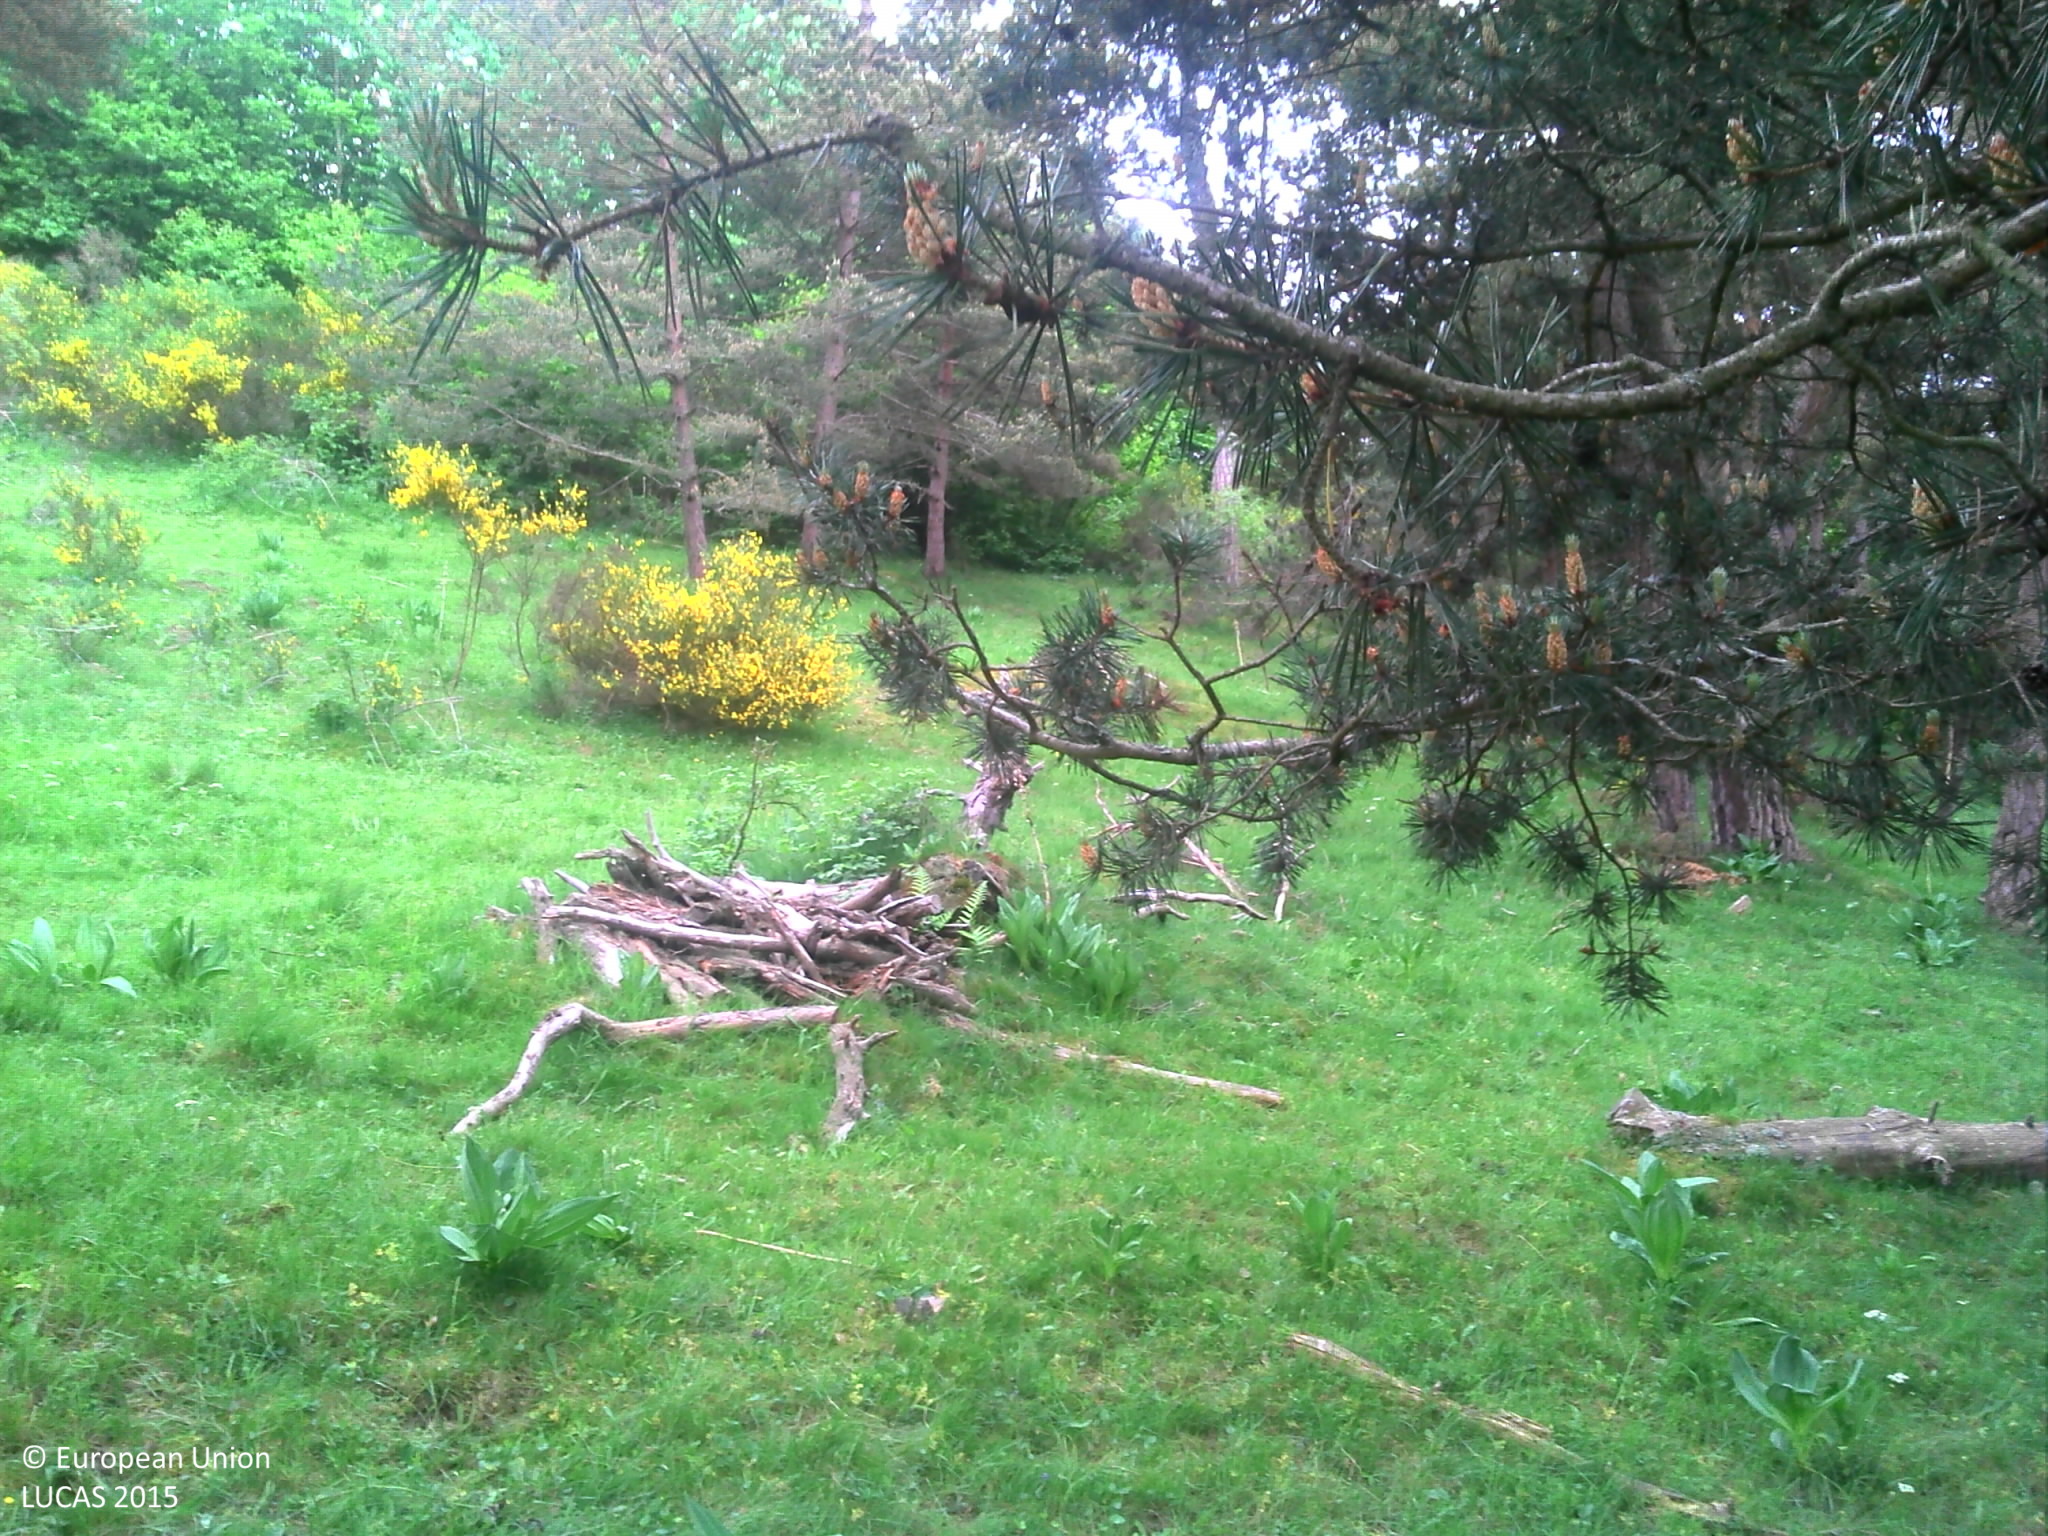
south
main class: Woodland
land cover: Pine dominated mixed woodland
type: alpine coniferous forest
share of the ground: > 75 %
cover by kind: coniferous forest trees 60 %, broadleaved forest trees 20 %, shrubs 10 %, herbaceous plants 10 %
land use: Forestry
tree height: > 5 m
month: June
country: FR
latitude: 45.0164
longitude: 3.2393
